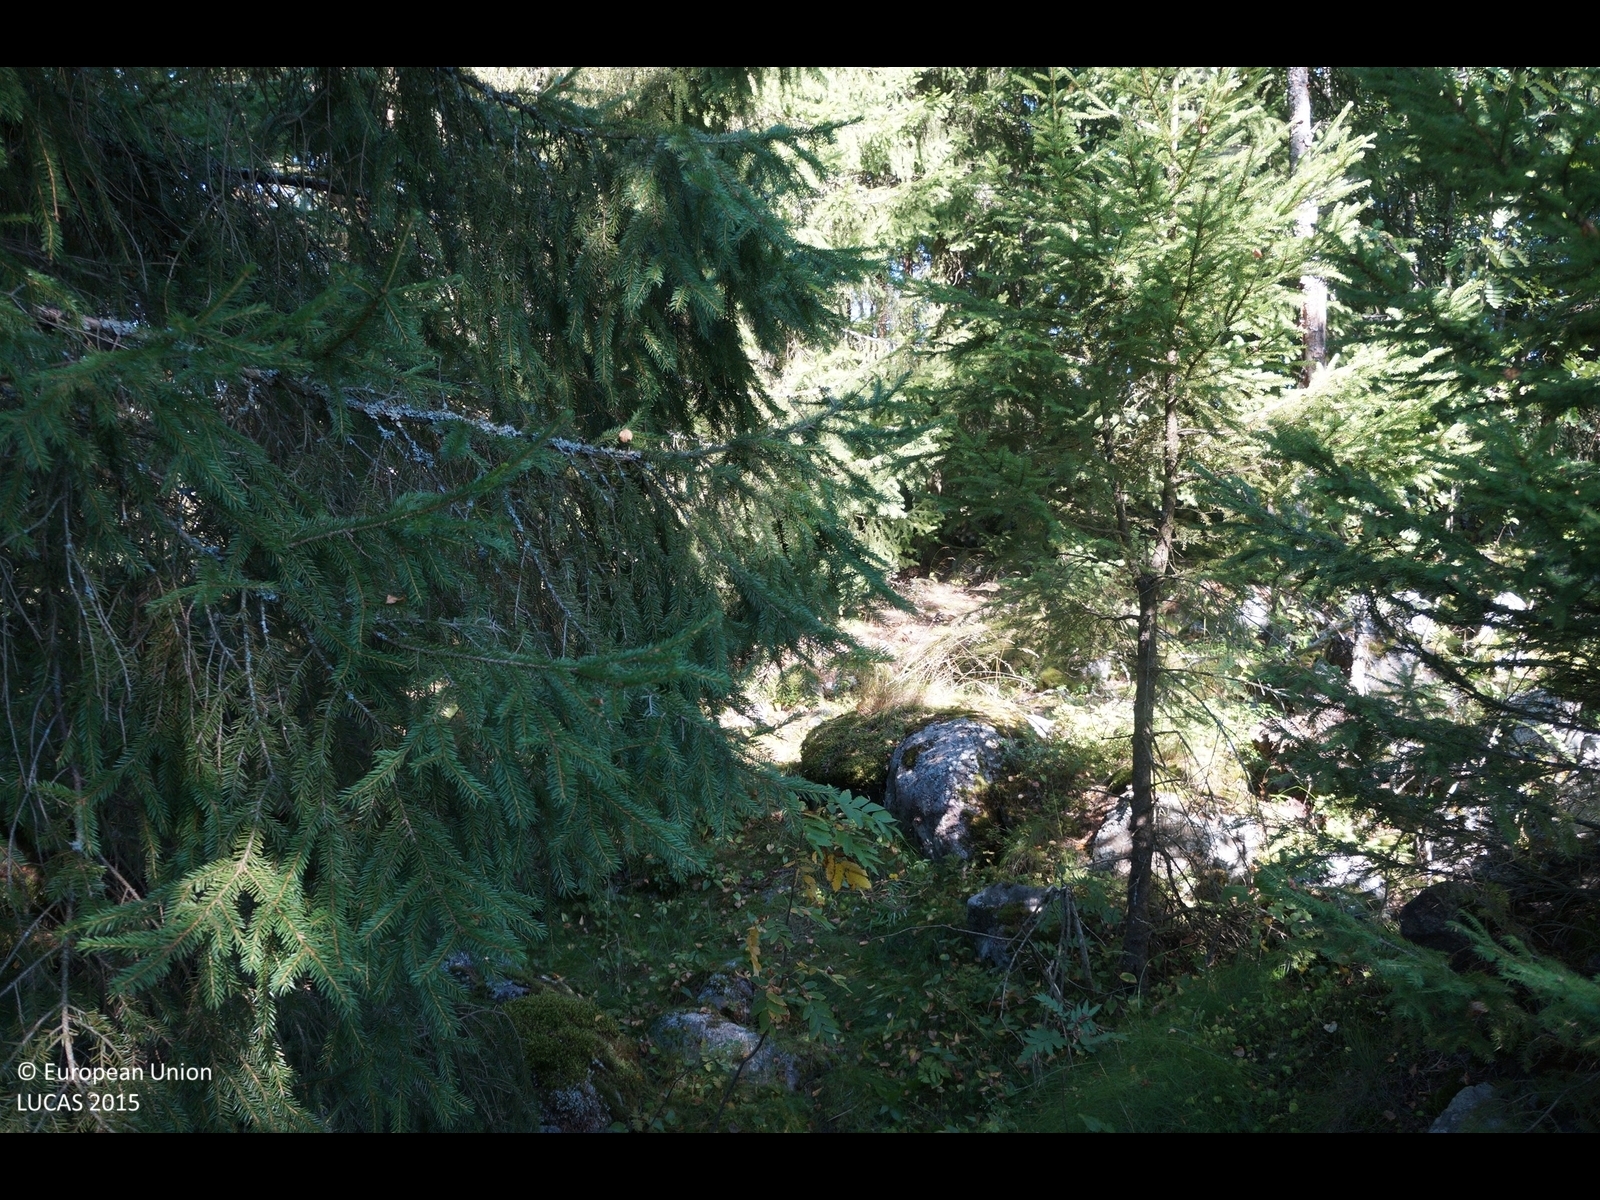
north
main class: Woodland
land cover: Spruce dominated mixed woodland
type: boreal forest
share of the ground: 50 - 75 %
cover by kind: coniferous forest trees 50 %, broadleaved forest trees 20 %, lichens and mosses 10 %, consolidated bare surface 10 %, shrubs 5 %, herbaceous plants 5 %
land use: Forestry
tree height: > 5 m
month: August
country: FI
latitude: 63.7506
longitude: 23.0015
